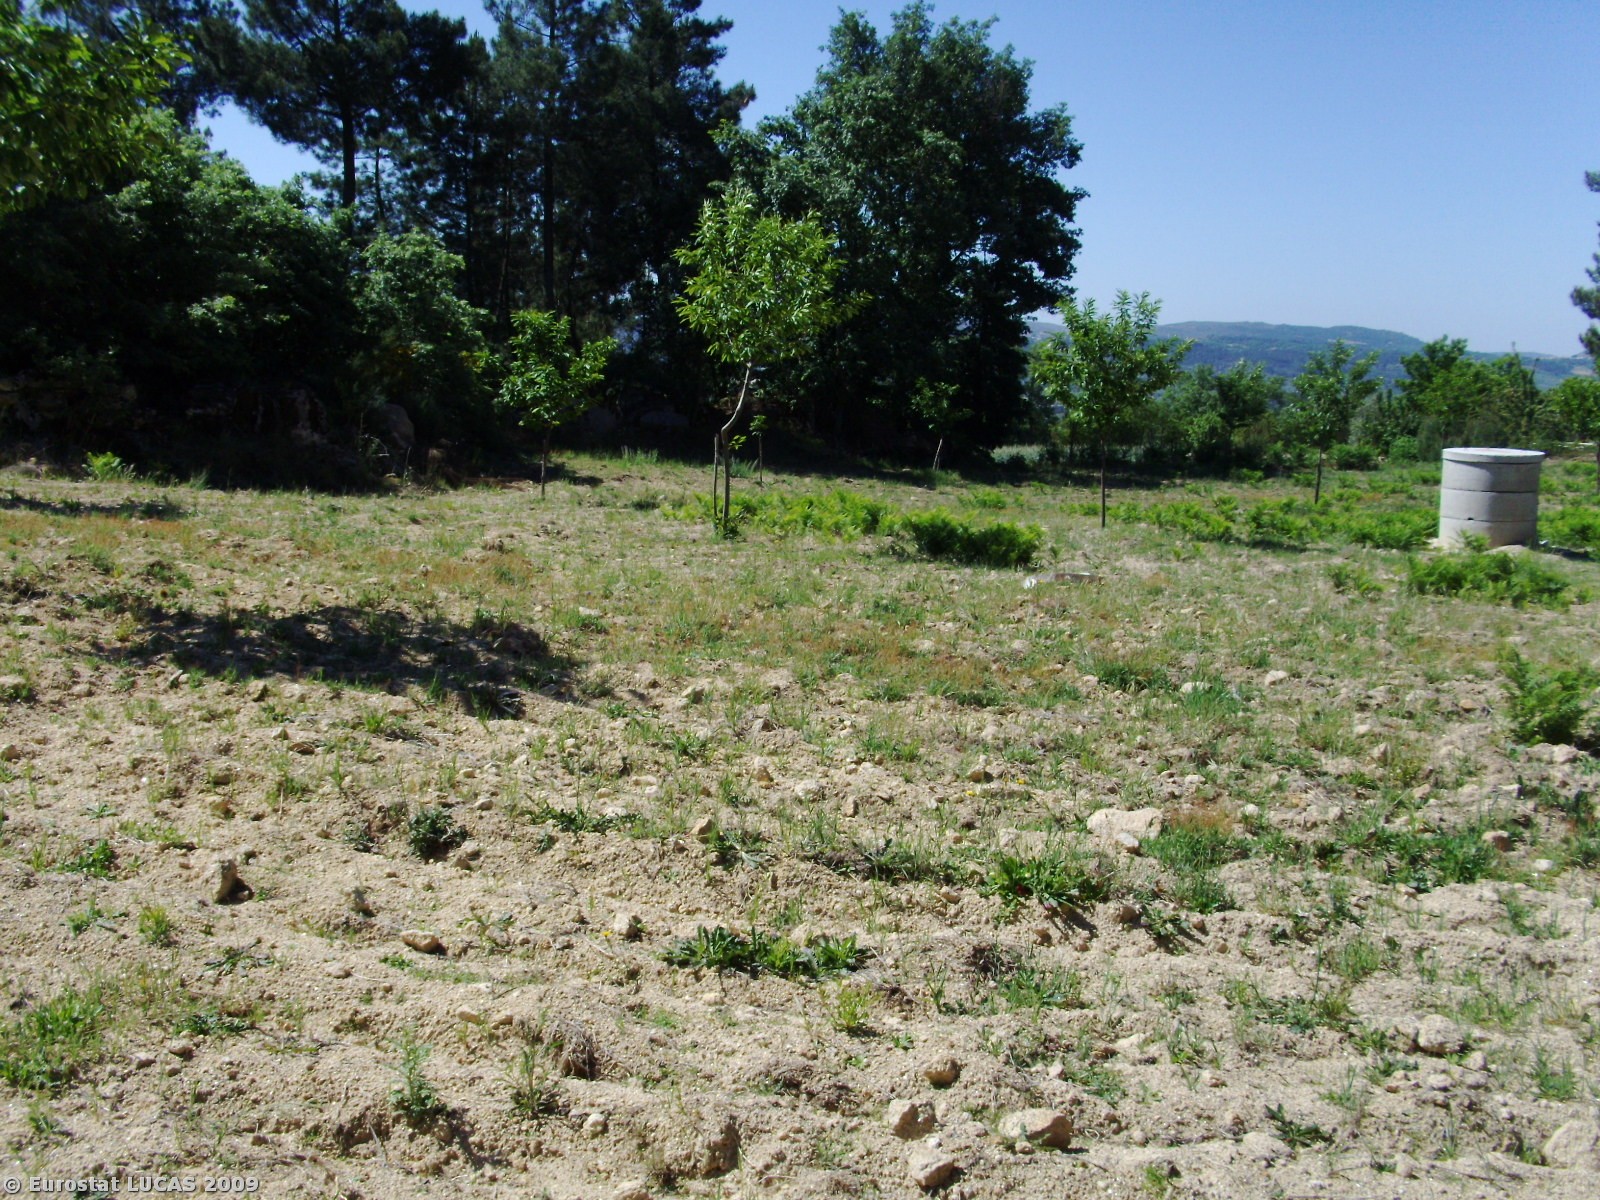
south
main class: Cropland
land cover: Nuts trees
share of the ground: 25 - 50 %
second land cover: Spontaneously vegetated surfaces
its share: 25 - 50 %
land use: Agriculture (excluding fallow land and kitchen gardens)
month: May
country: PT
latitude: 40.9590
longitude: -7.4520
